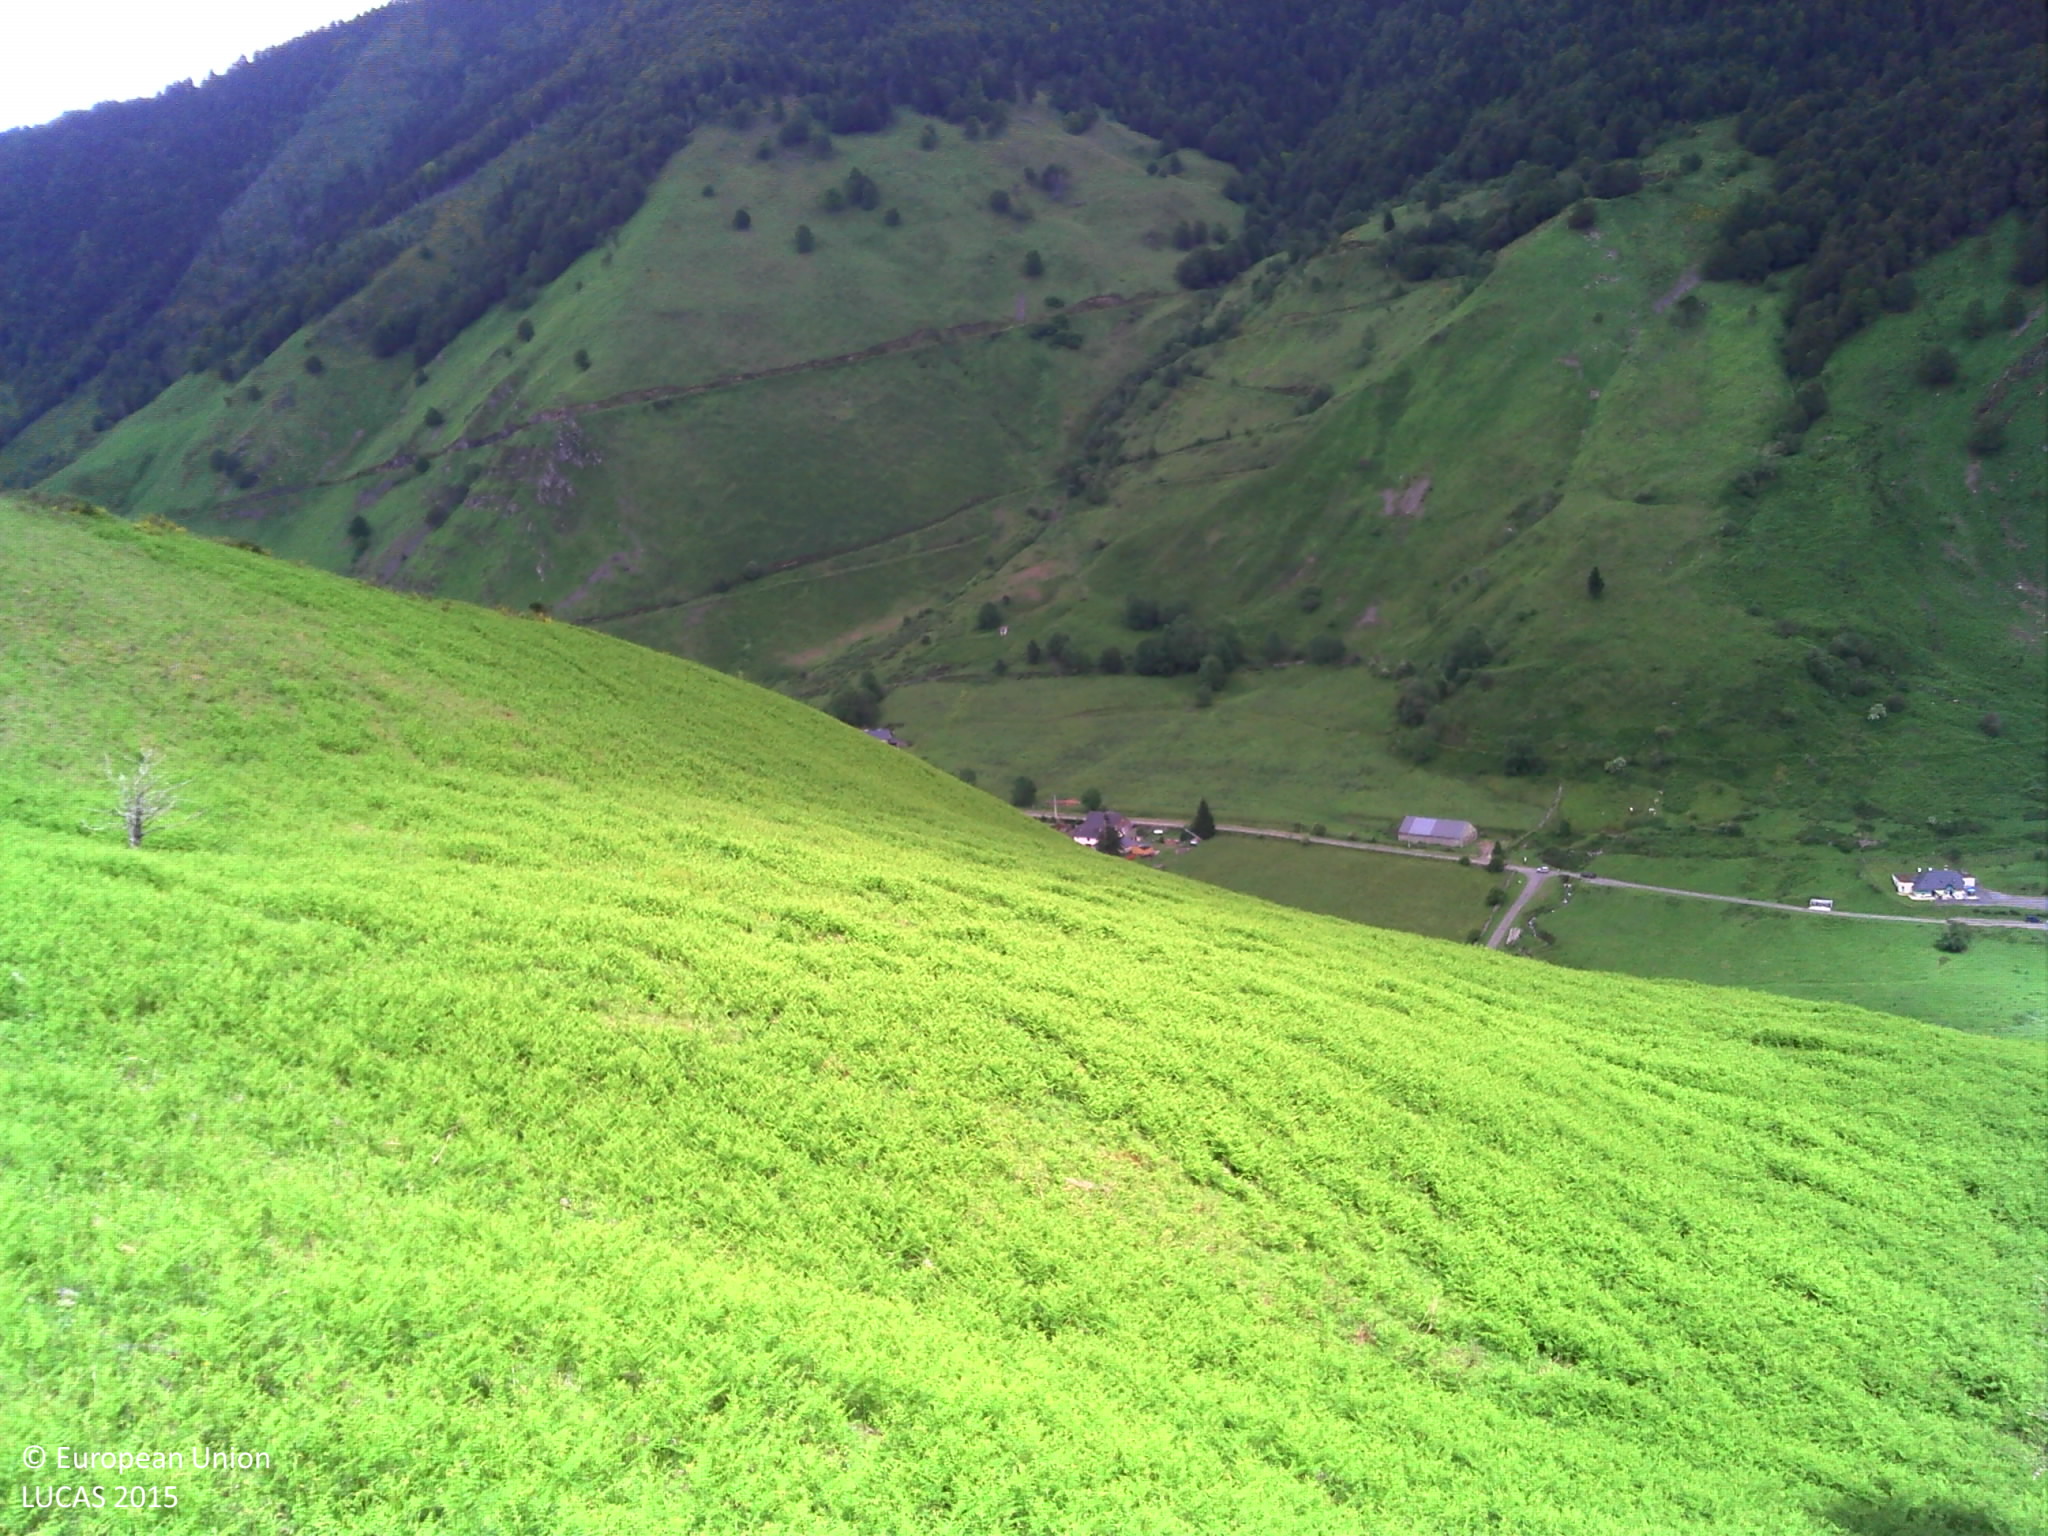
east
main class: Grassland
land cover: Grassland without tree/shrub cover
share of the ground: > 75 %
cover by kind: herbaceous plants 100 %
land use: Agriculture (excluding fallow land and kitchen gardens)
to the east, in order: Grassland without tree/shrub cover; Tracks; Shrubland without tree cover
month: June
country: FR
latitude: 42.9123
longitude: -0.6262
